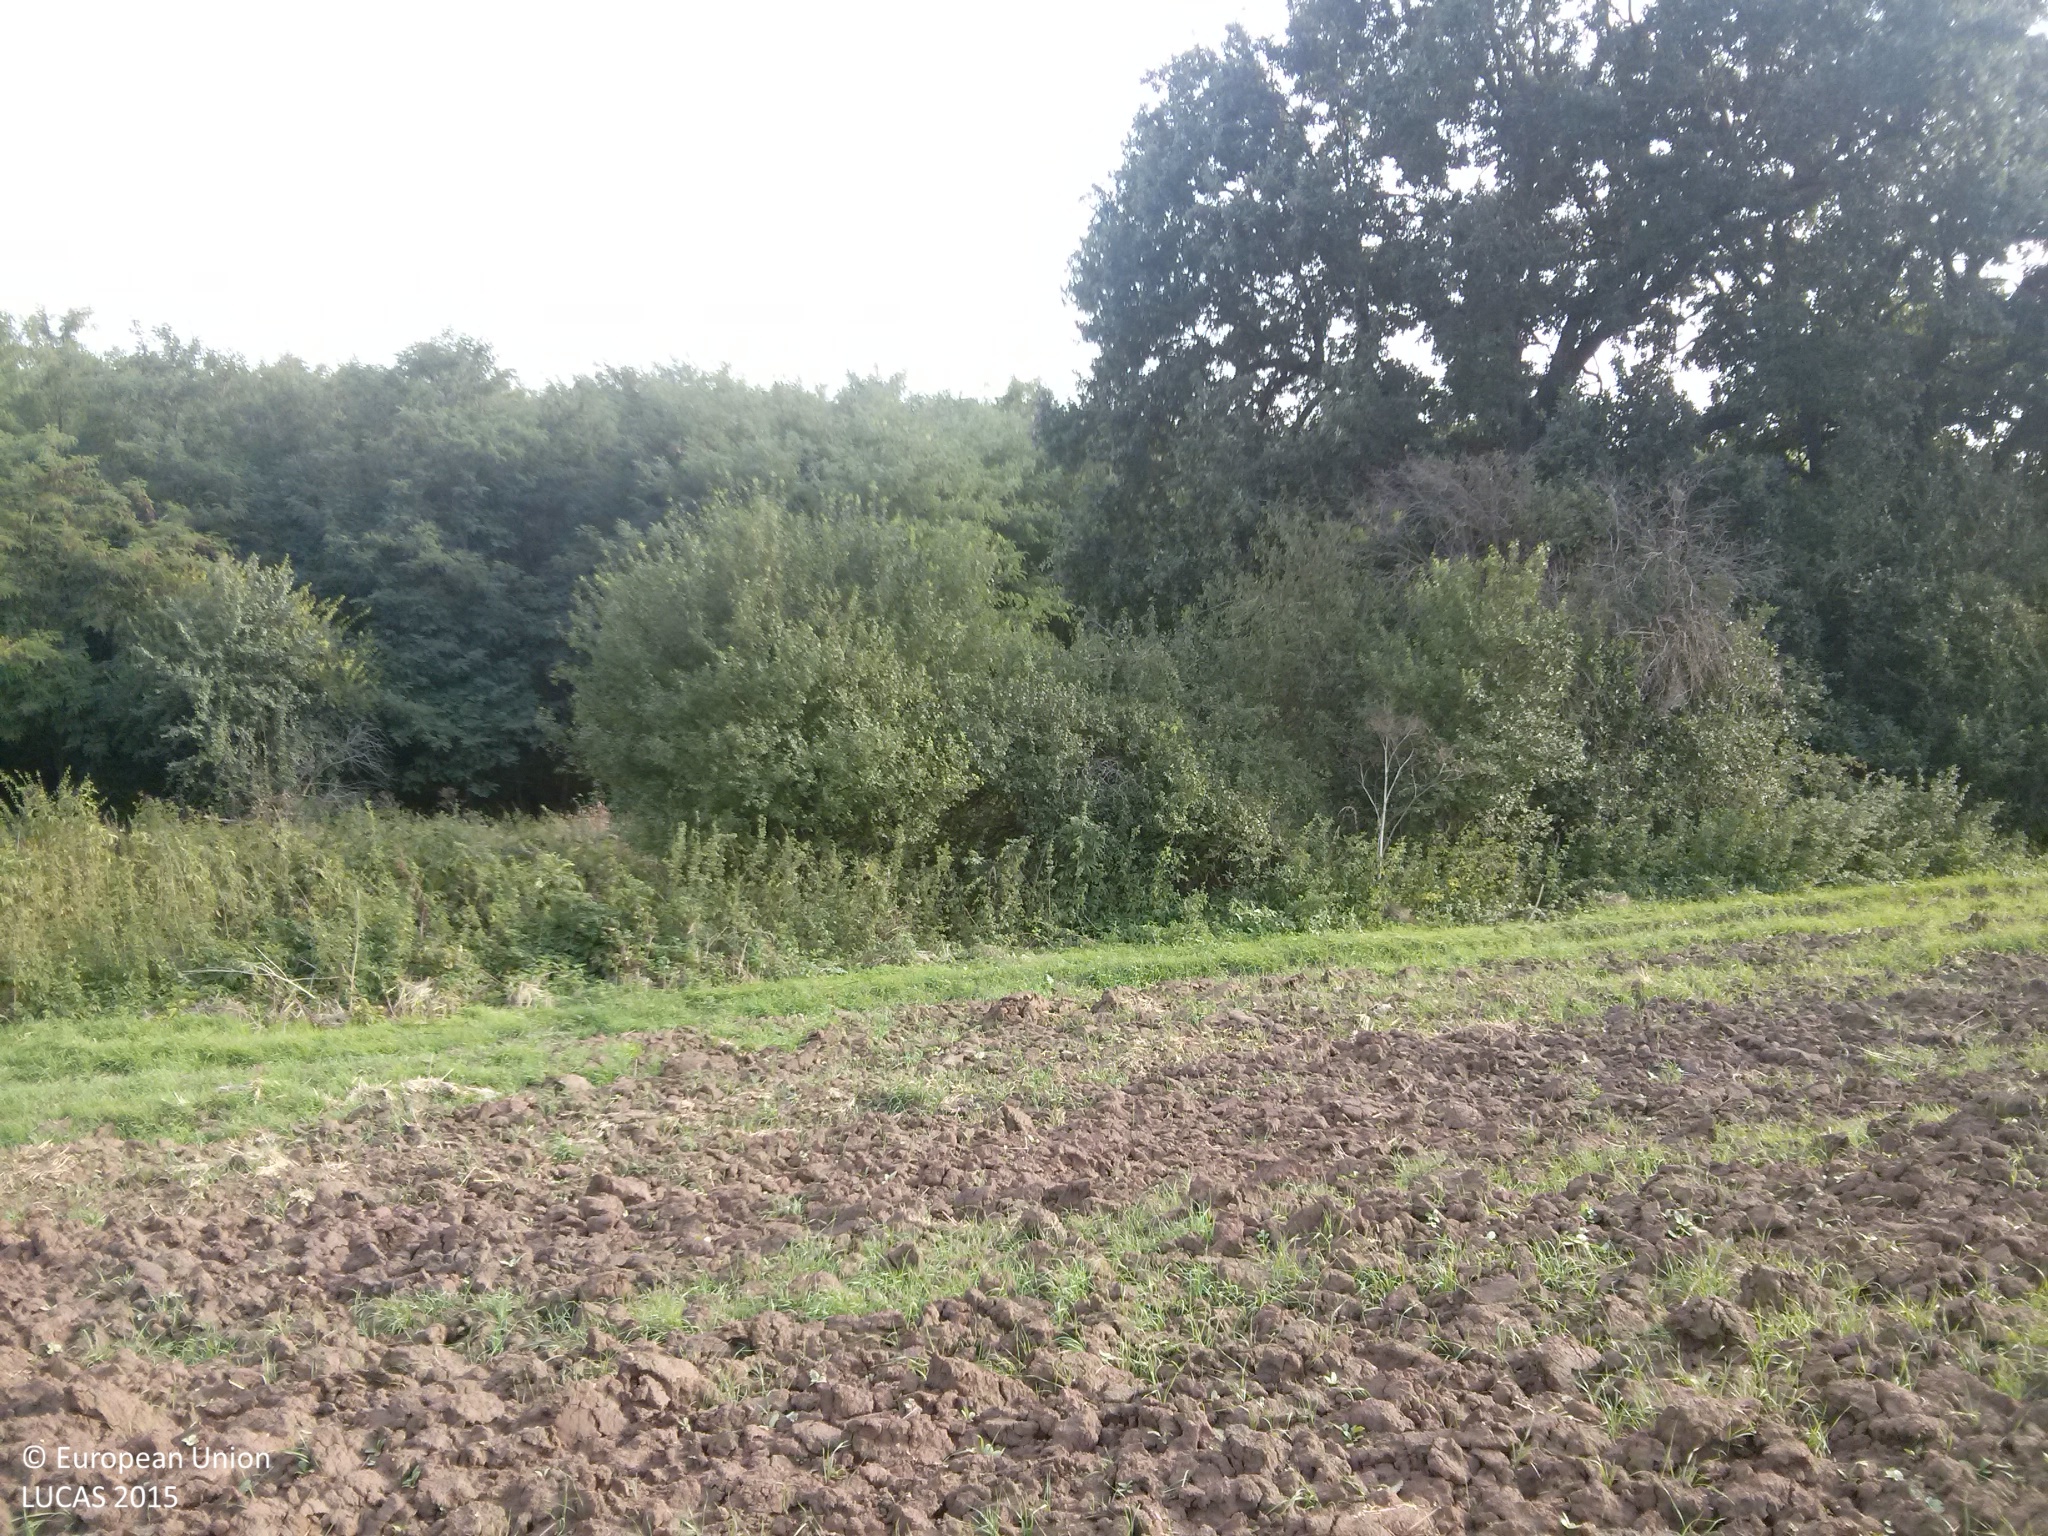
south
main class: Cropland
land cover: Common wheat
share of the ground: < 10 %
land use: Agriculture (excluding fallow land and kitchen gardens)
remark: Harvested field
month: September
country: BG
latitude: 43.7265
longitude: 26.3281
